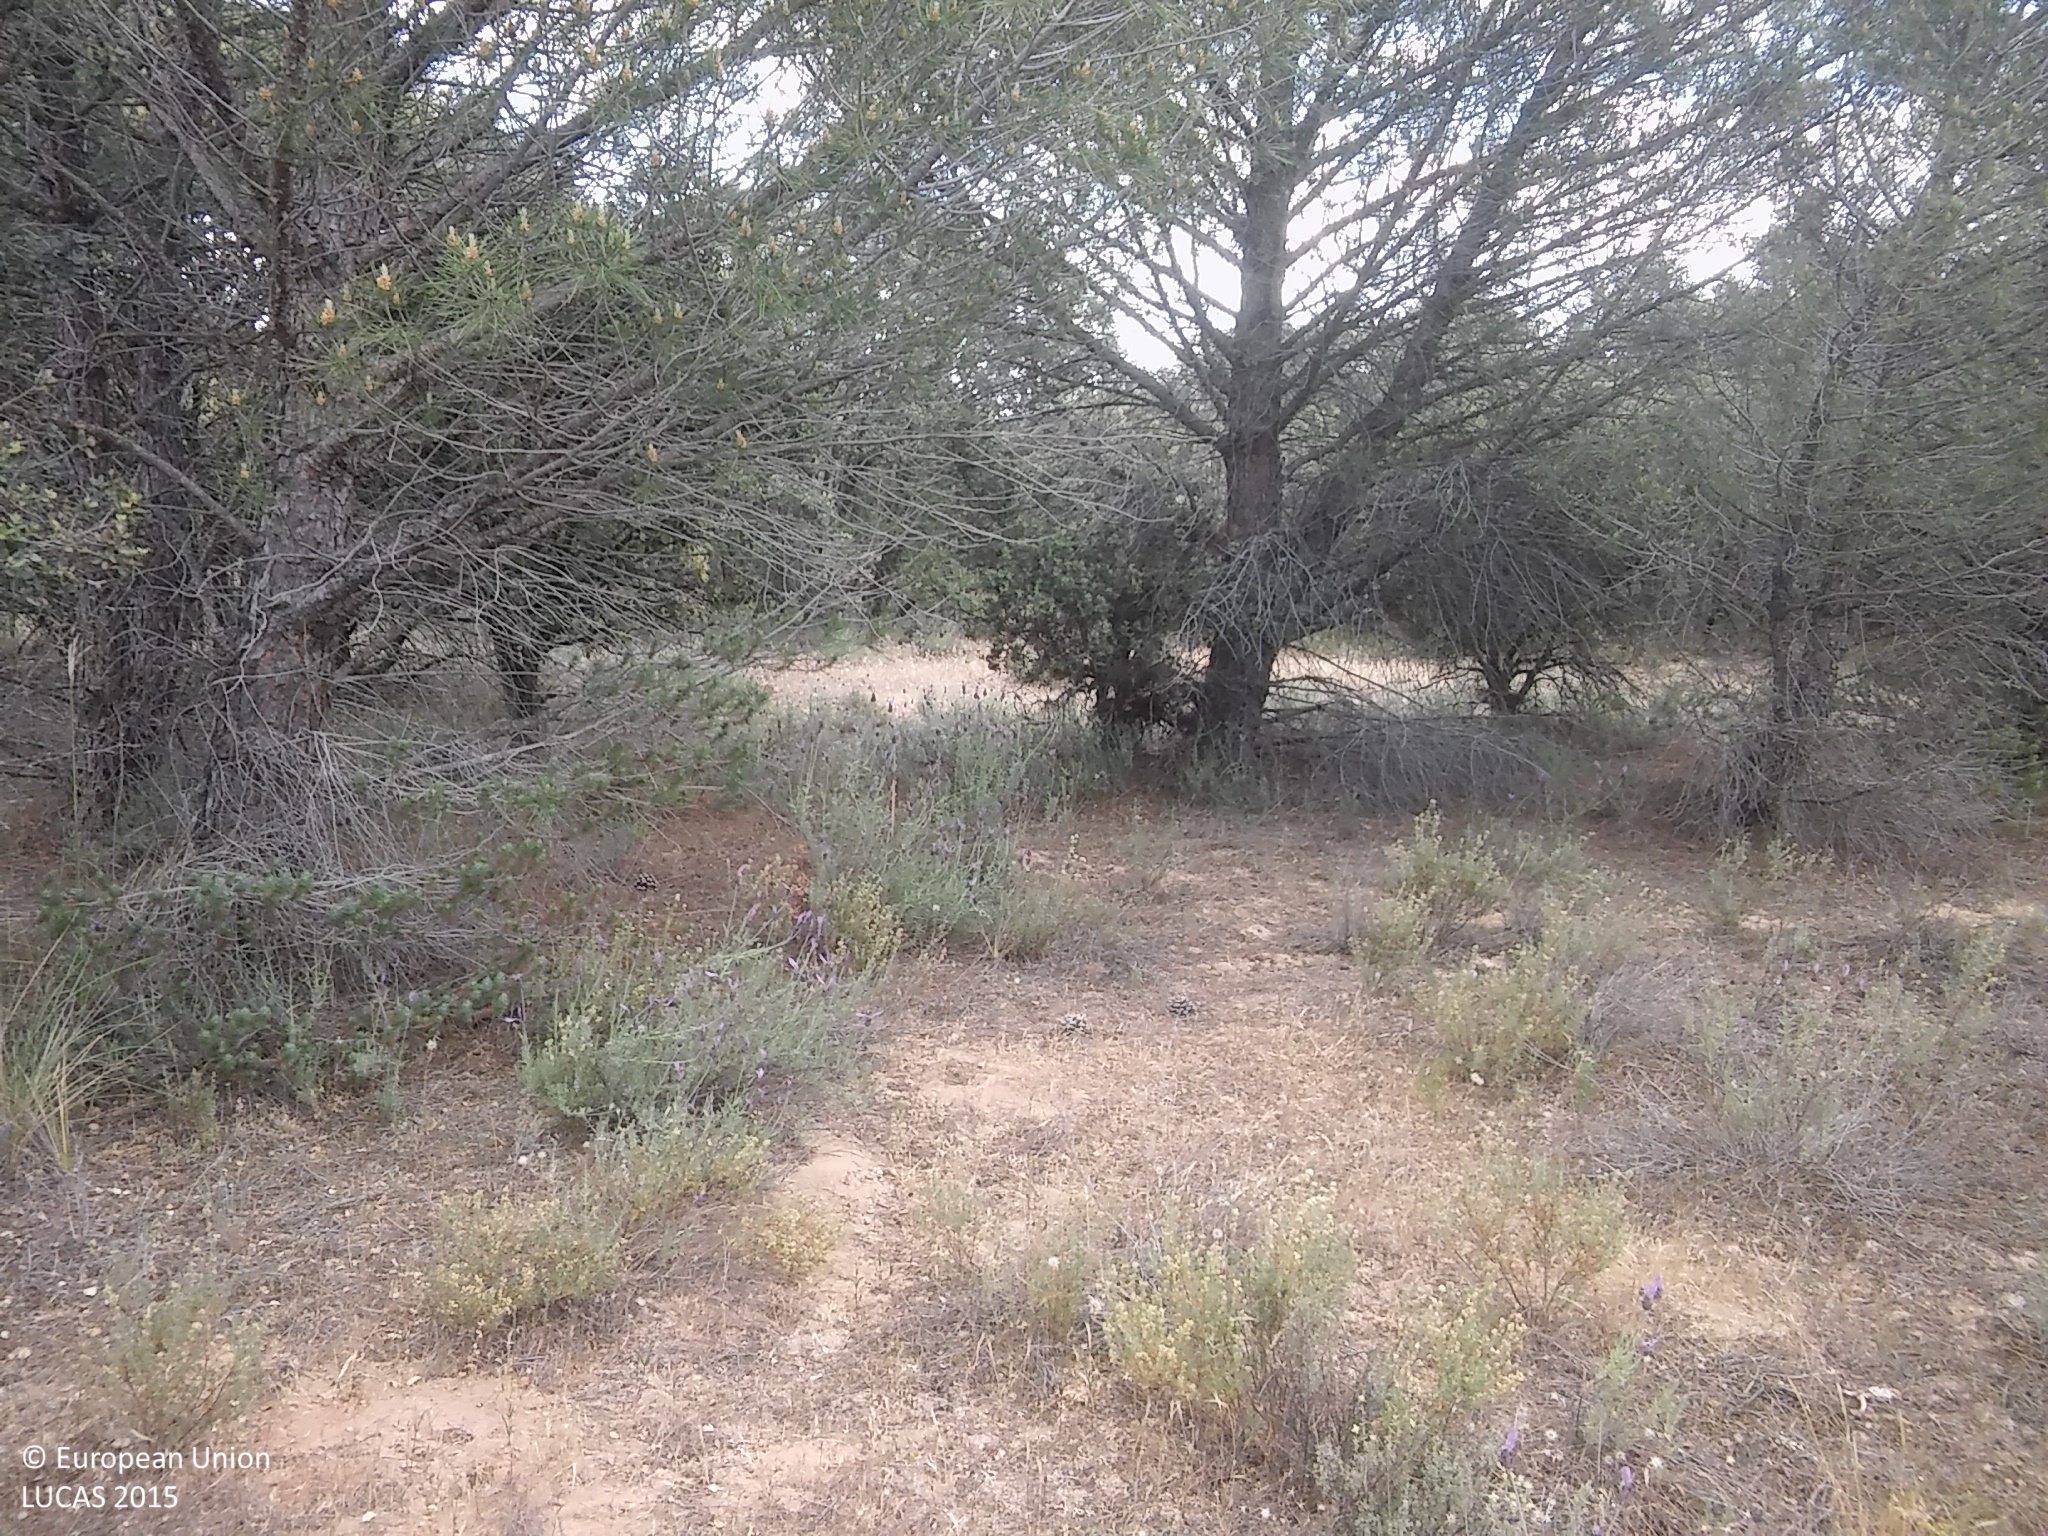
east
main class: Woodland
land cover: Broadleaved woodland
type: broadleaved evergreen forest
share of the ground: 25 - 50 %
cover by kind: broadleaved forest trees 30 %, shrubs 30 %, unconsolidated bare surface 30 %, coniferous forest trees 10 %
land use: Forestry
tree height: > 5 m
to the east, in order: Broadleaved woodland; Tracks; Broadleaved woodland
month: June
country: ES
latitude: 41.6557
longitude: -3.7550
